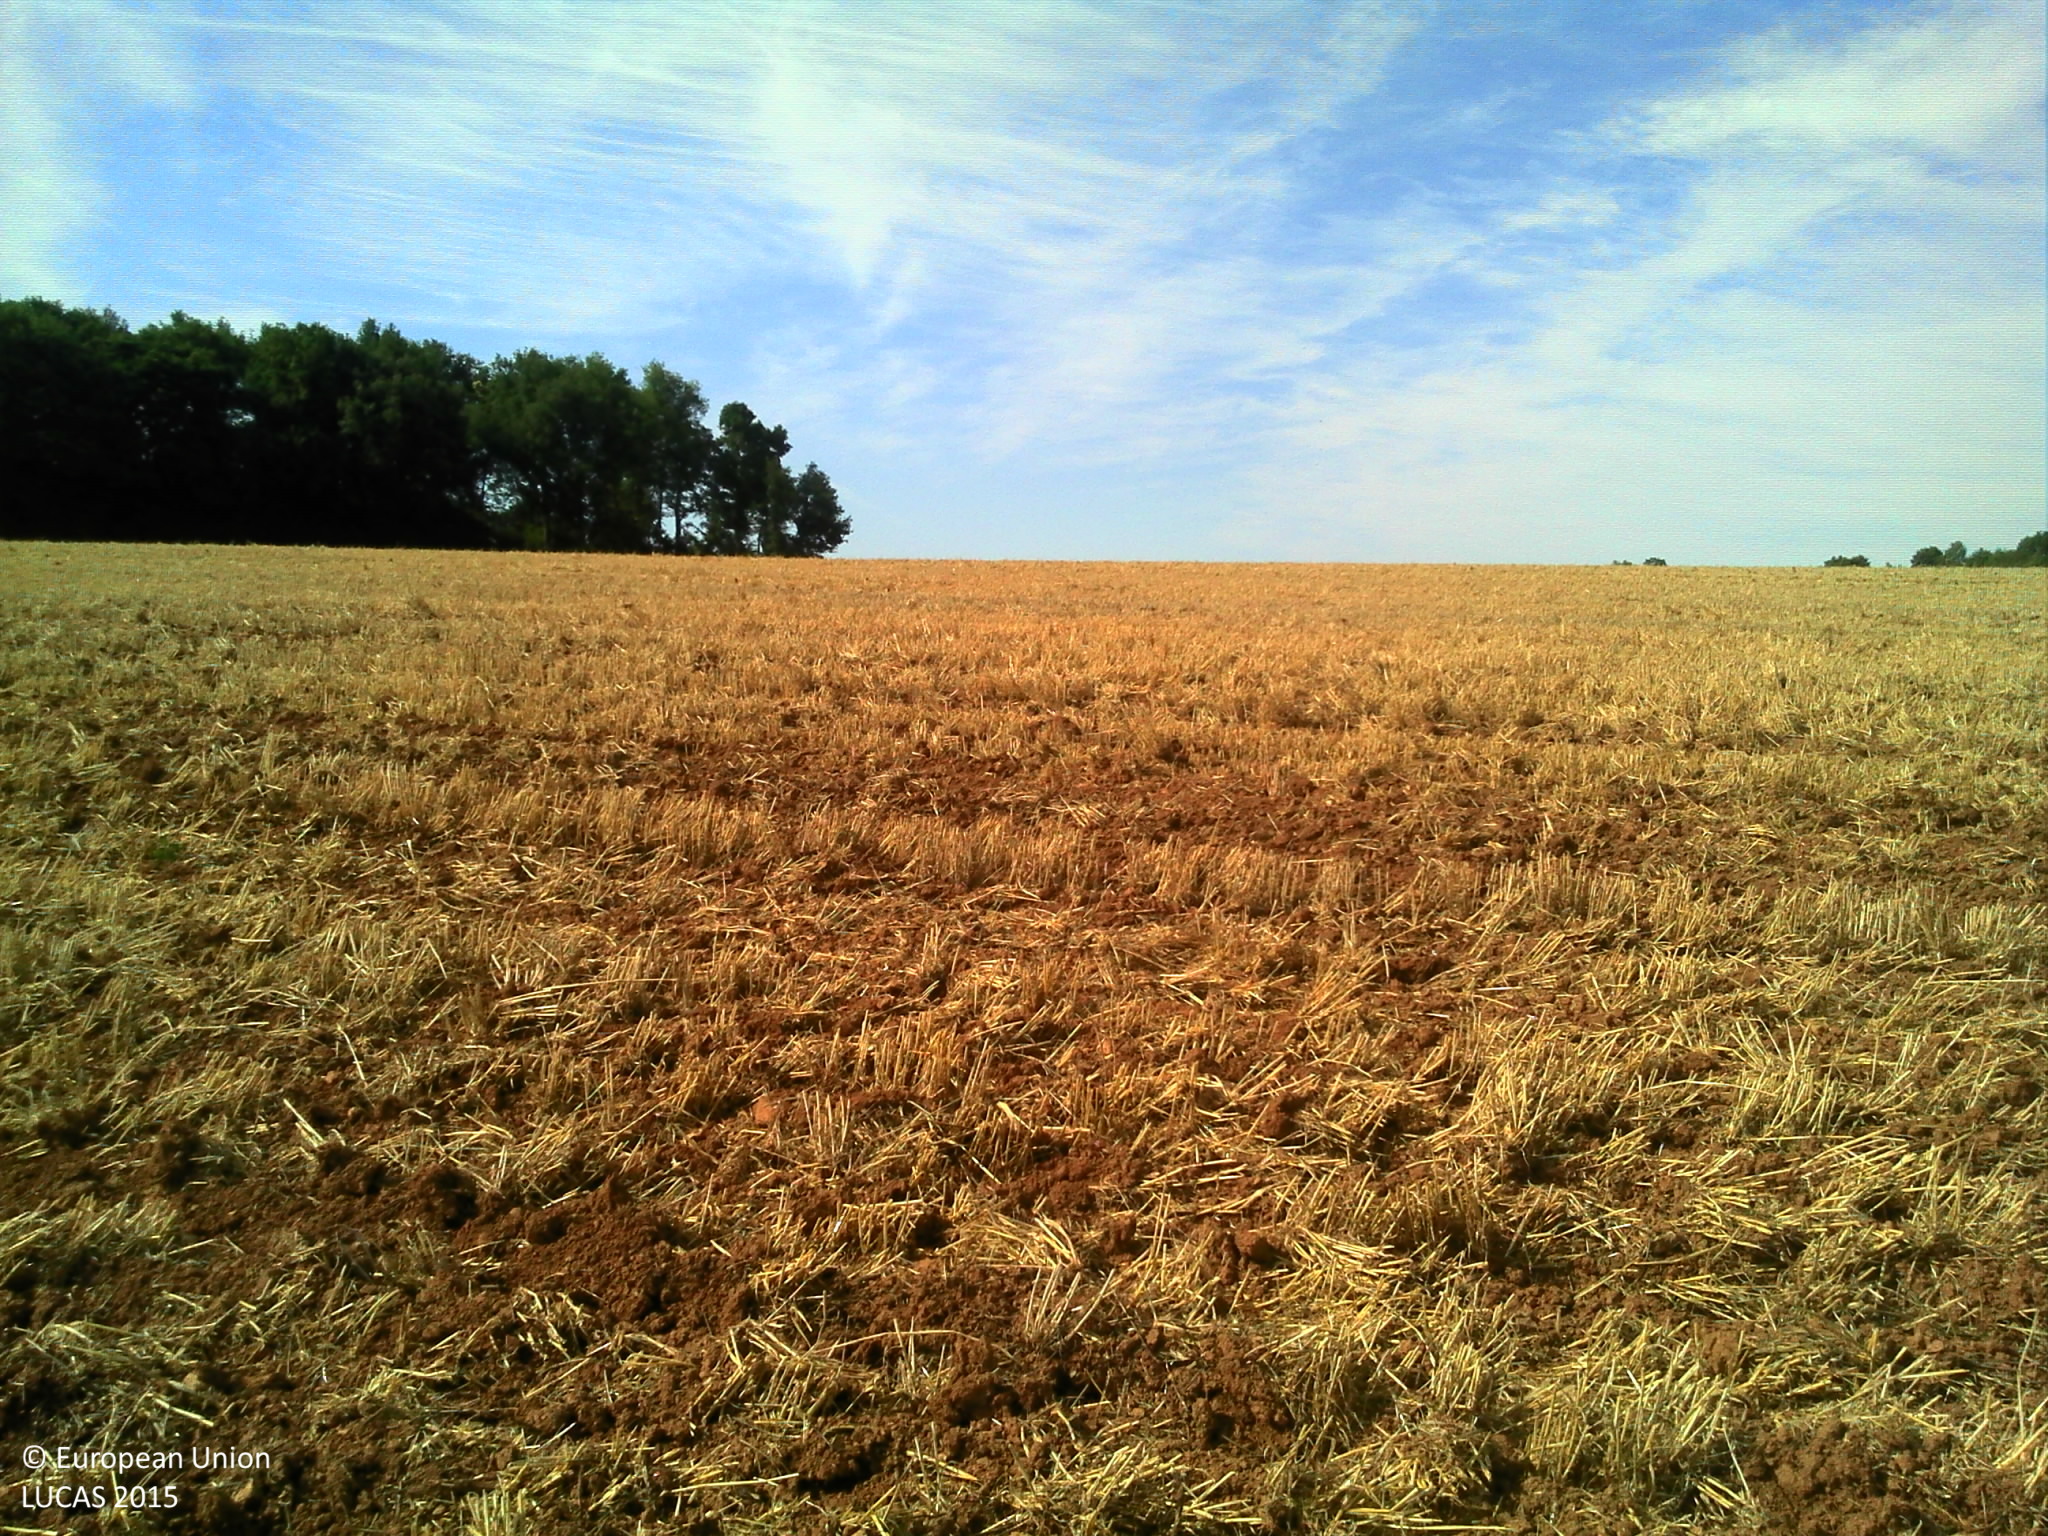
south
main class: Cropland
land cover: Barley
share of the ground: < 10 %
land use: Agriculture (excluding fallow land and kitchen gardens)
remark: Harvested field
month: June
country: FR
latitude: 46.4875
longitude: 0.2755
